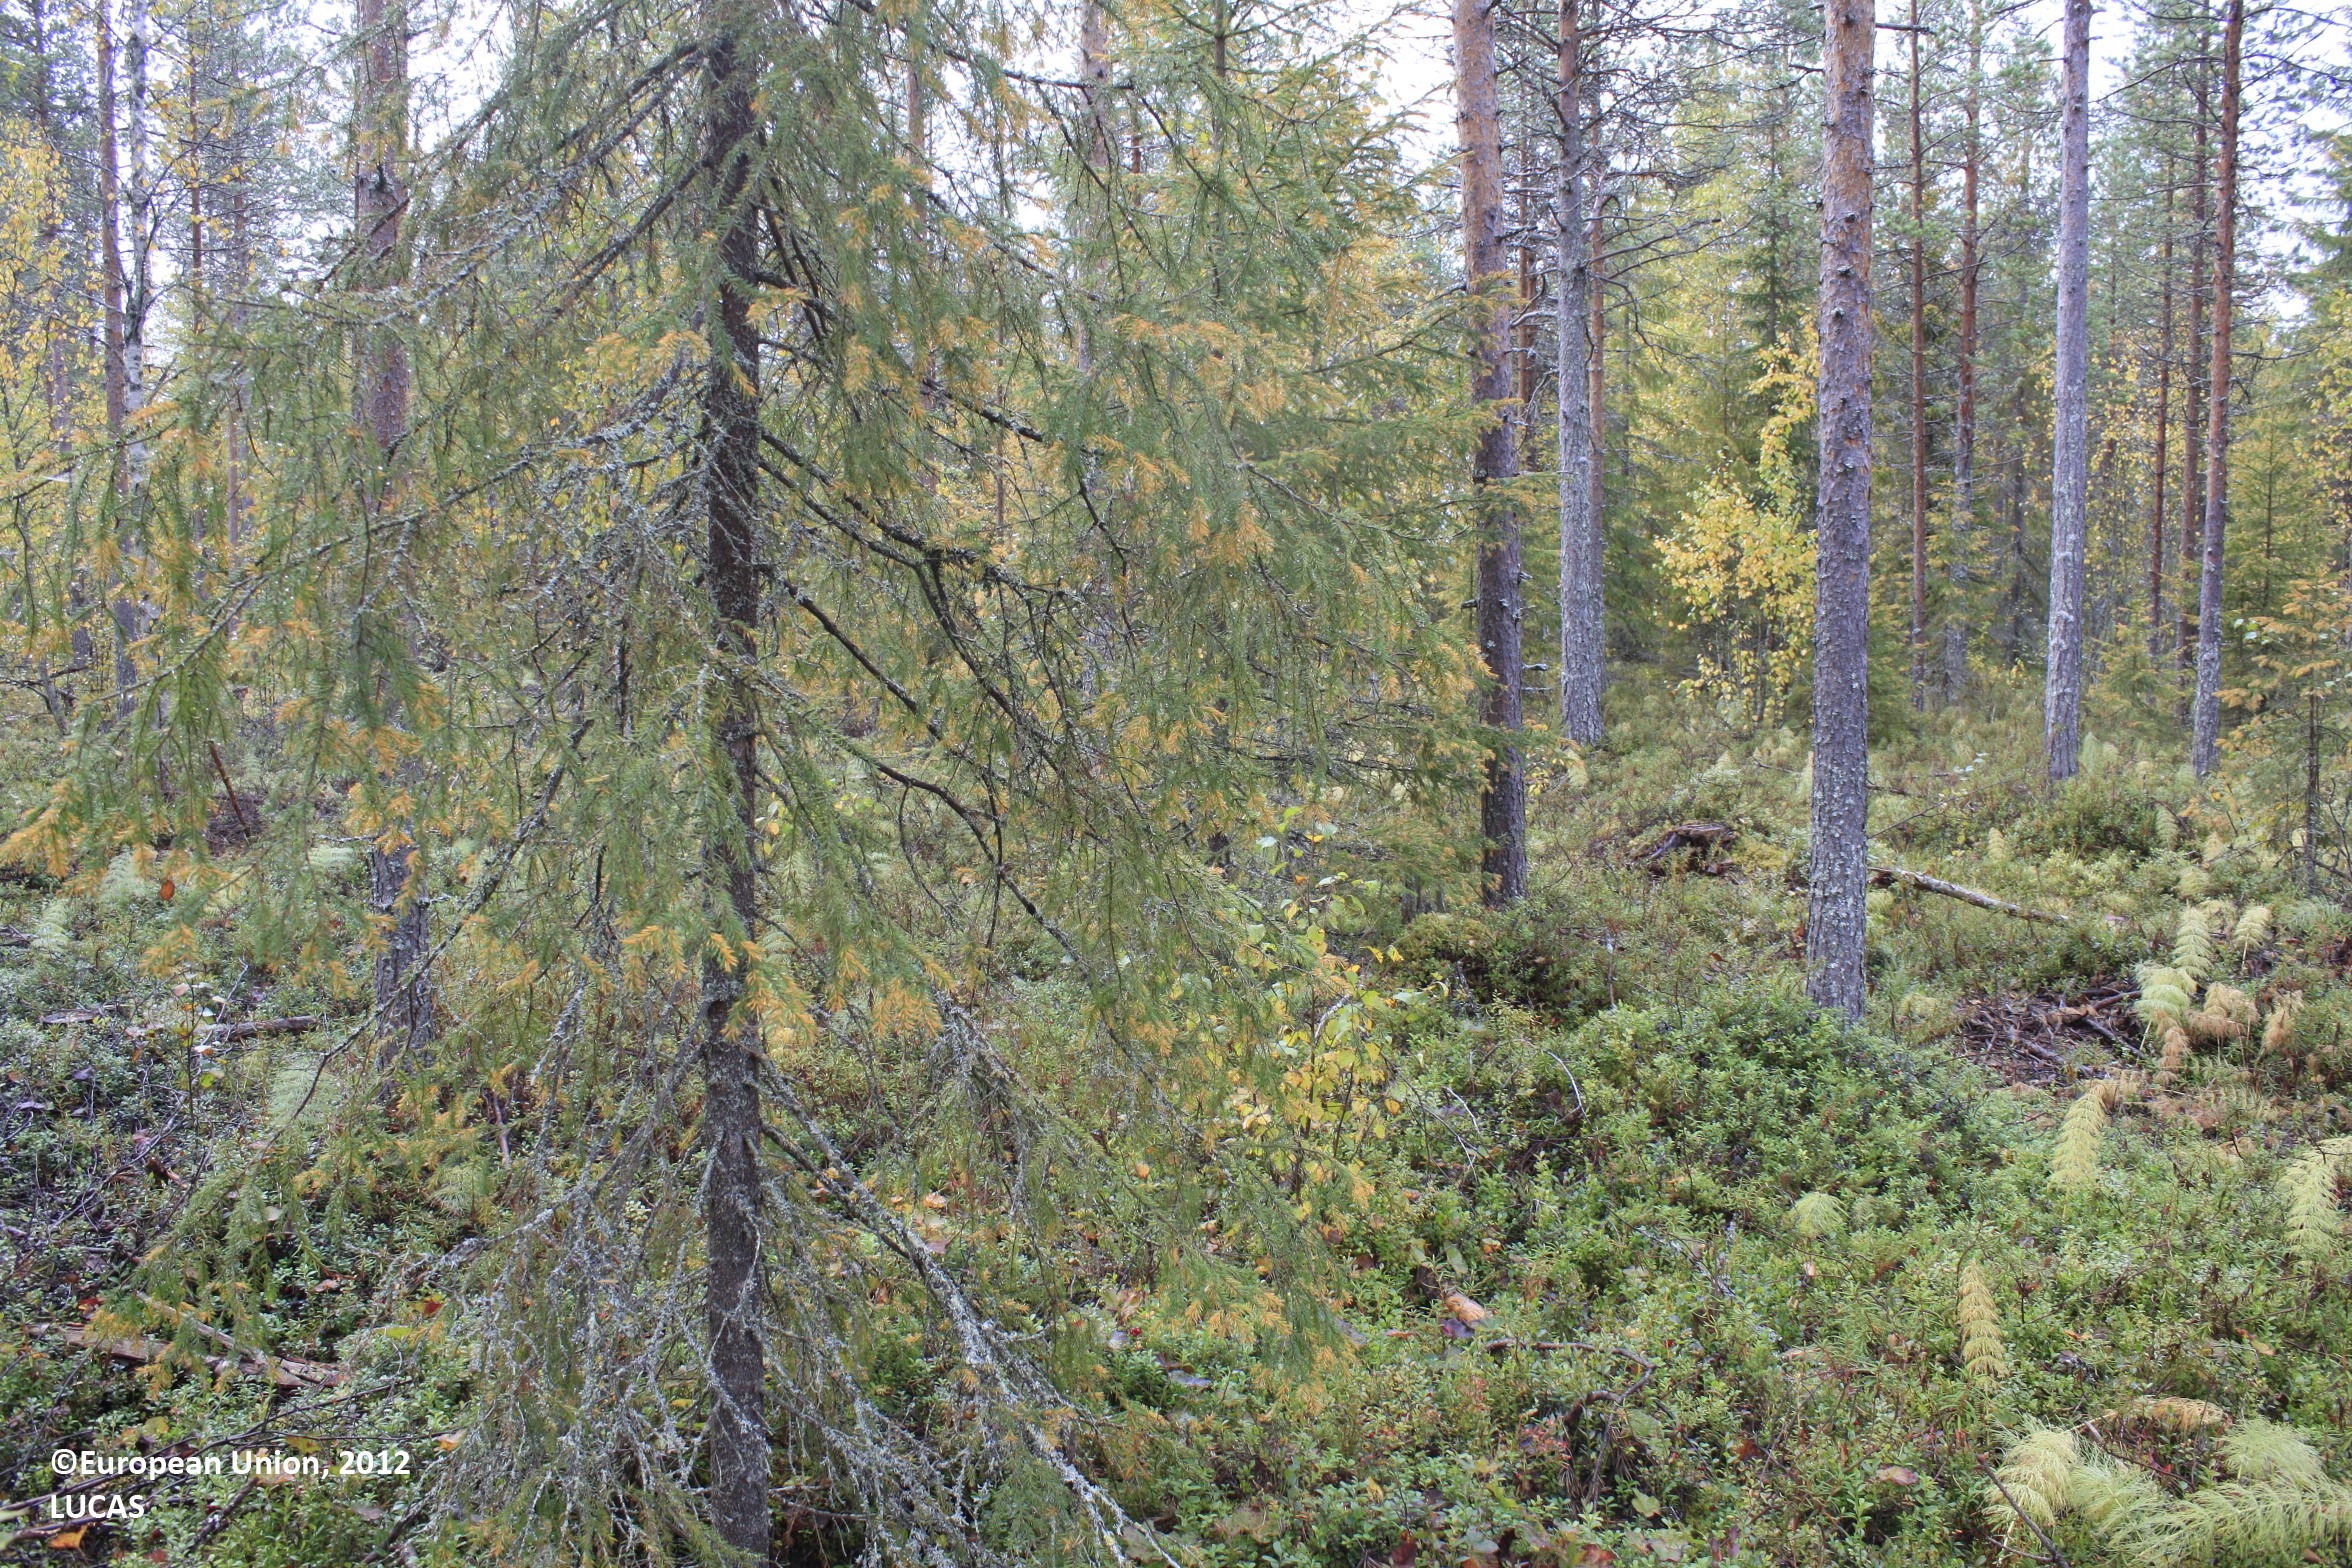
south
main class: Woodland
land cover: Pine dominated mixed woodland
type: boreal forest
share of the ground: 25 - 50 %
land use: Forestry
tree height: > 5 m
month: September
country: FI
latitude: 65.5406
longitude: 26.5744
